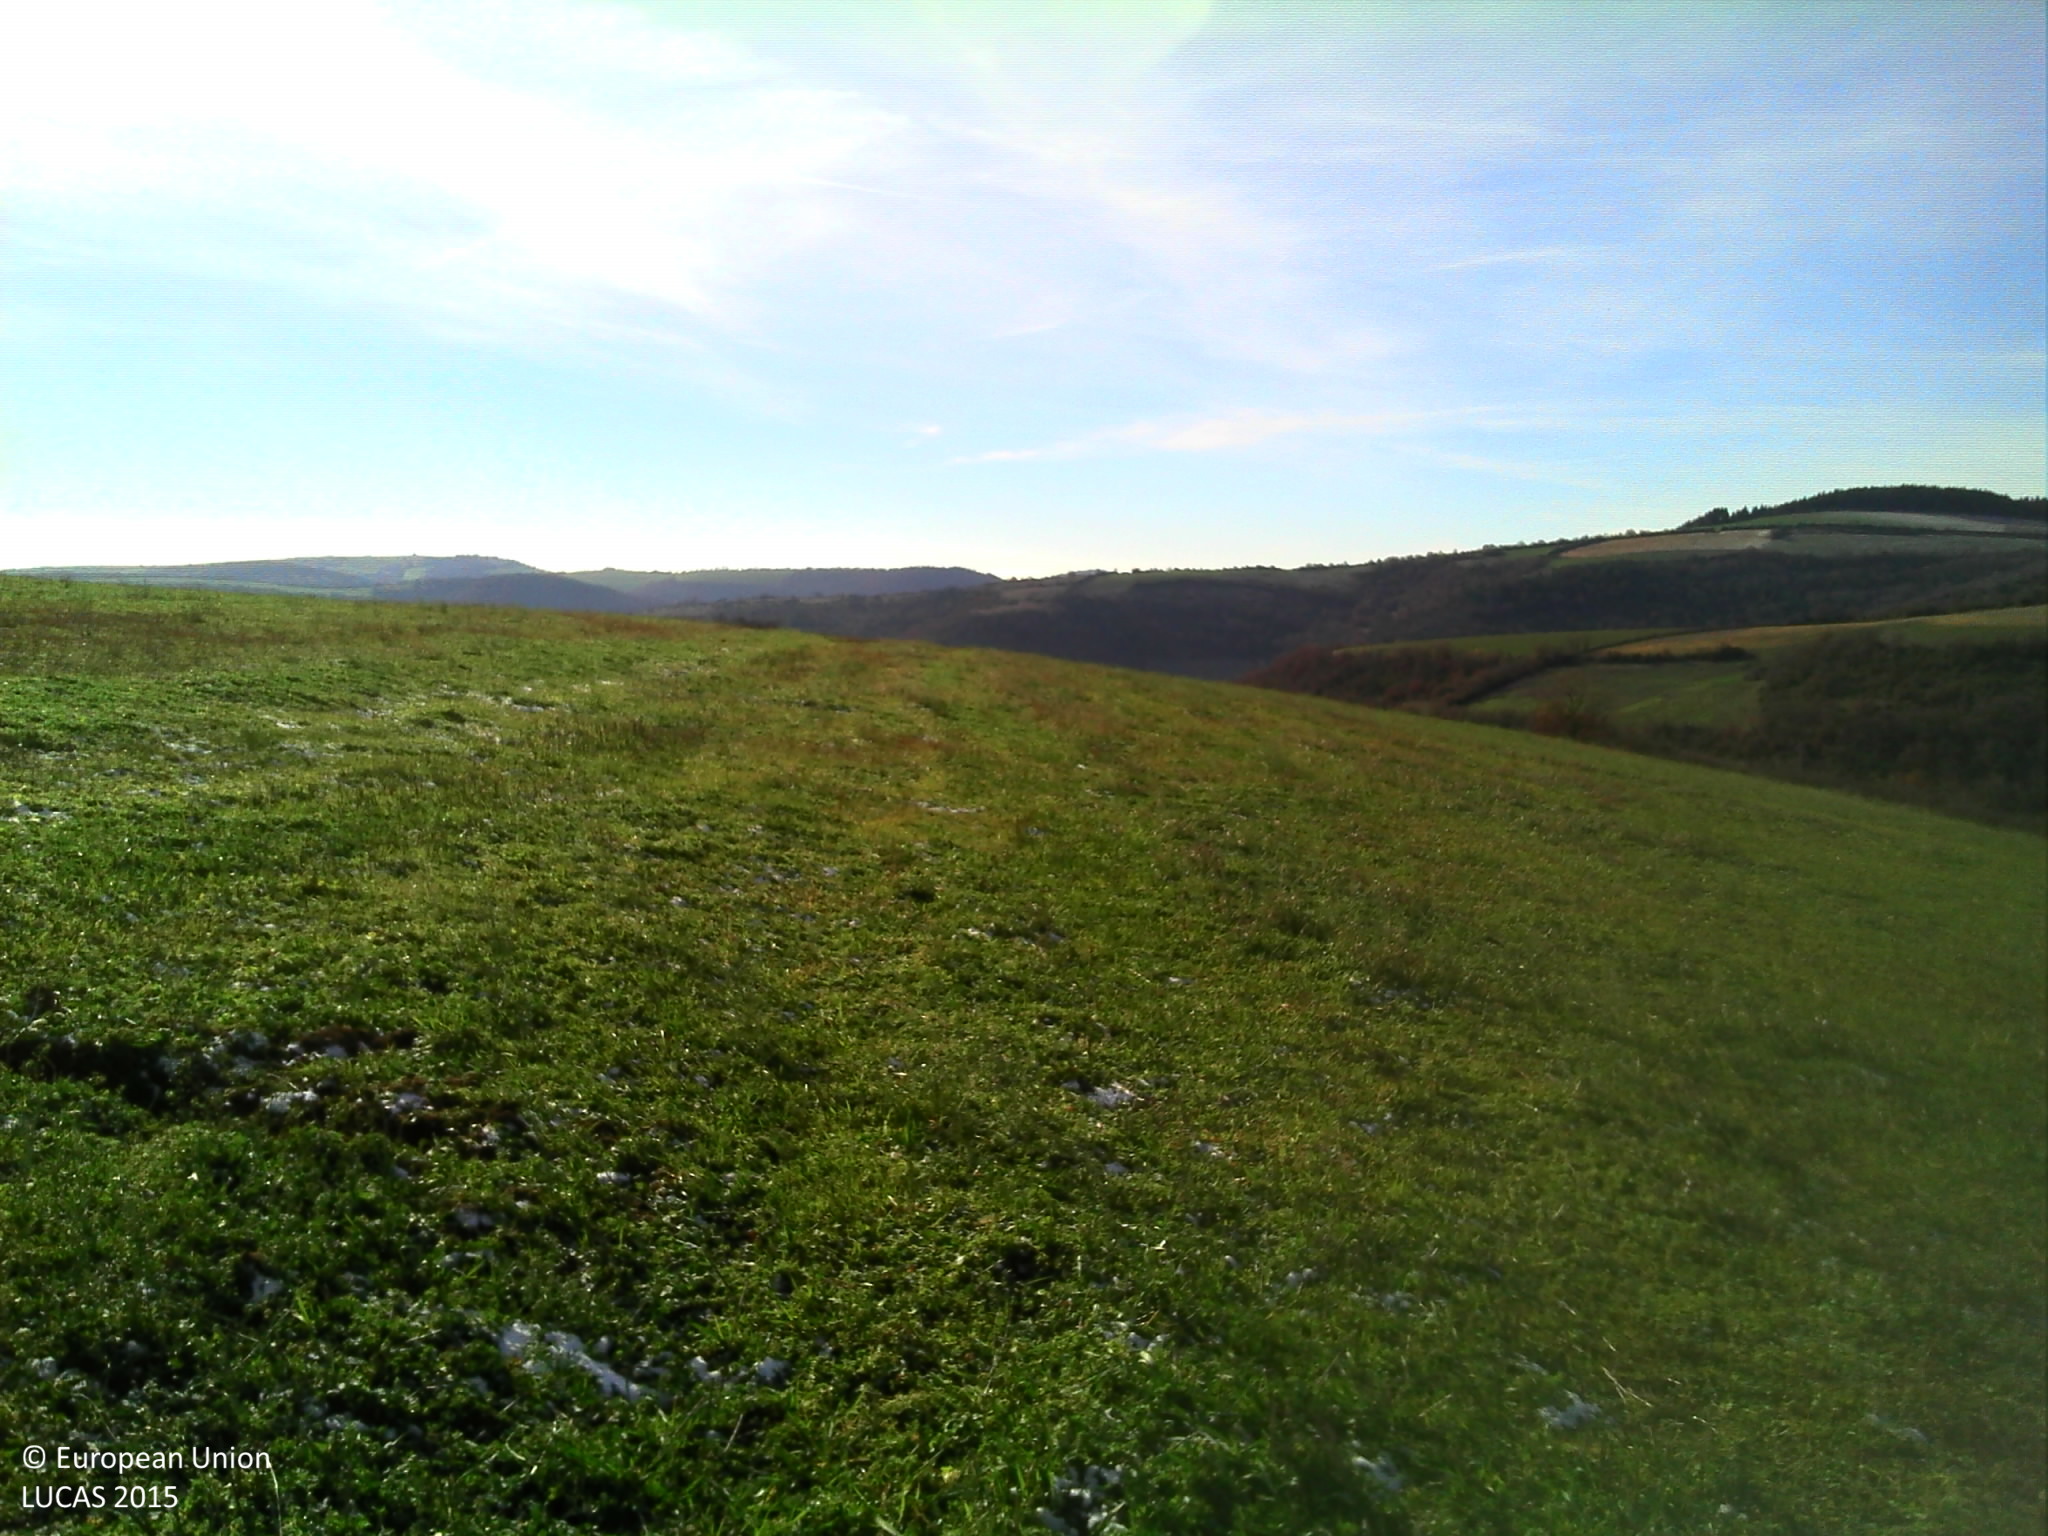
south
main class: Cropland
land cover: Temporary grasslands
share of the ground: > 75 %
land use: Agriculture (excluding fallow land and kitchen gardens)
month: November
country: FR
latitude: 44.2035
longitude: 2.9850
